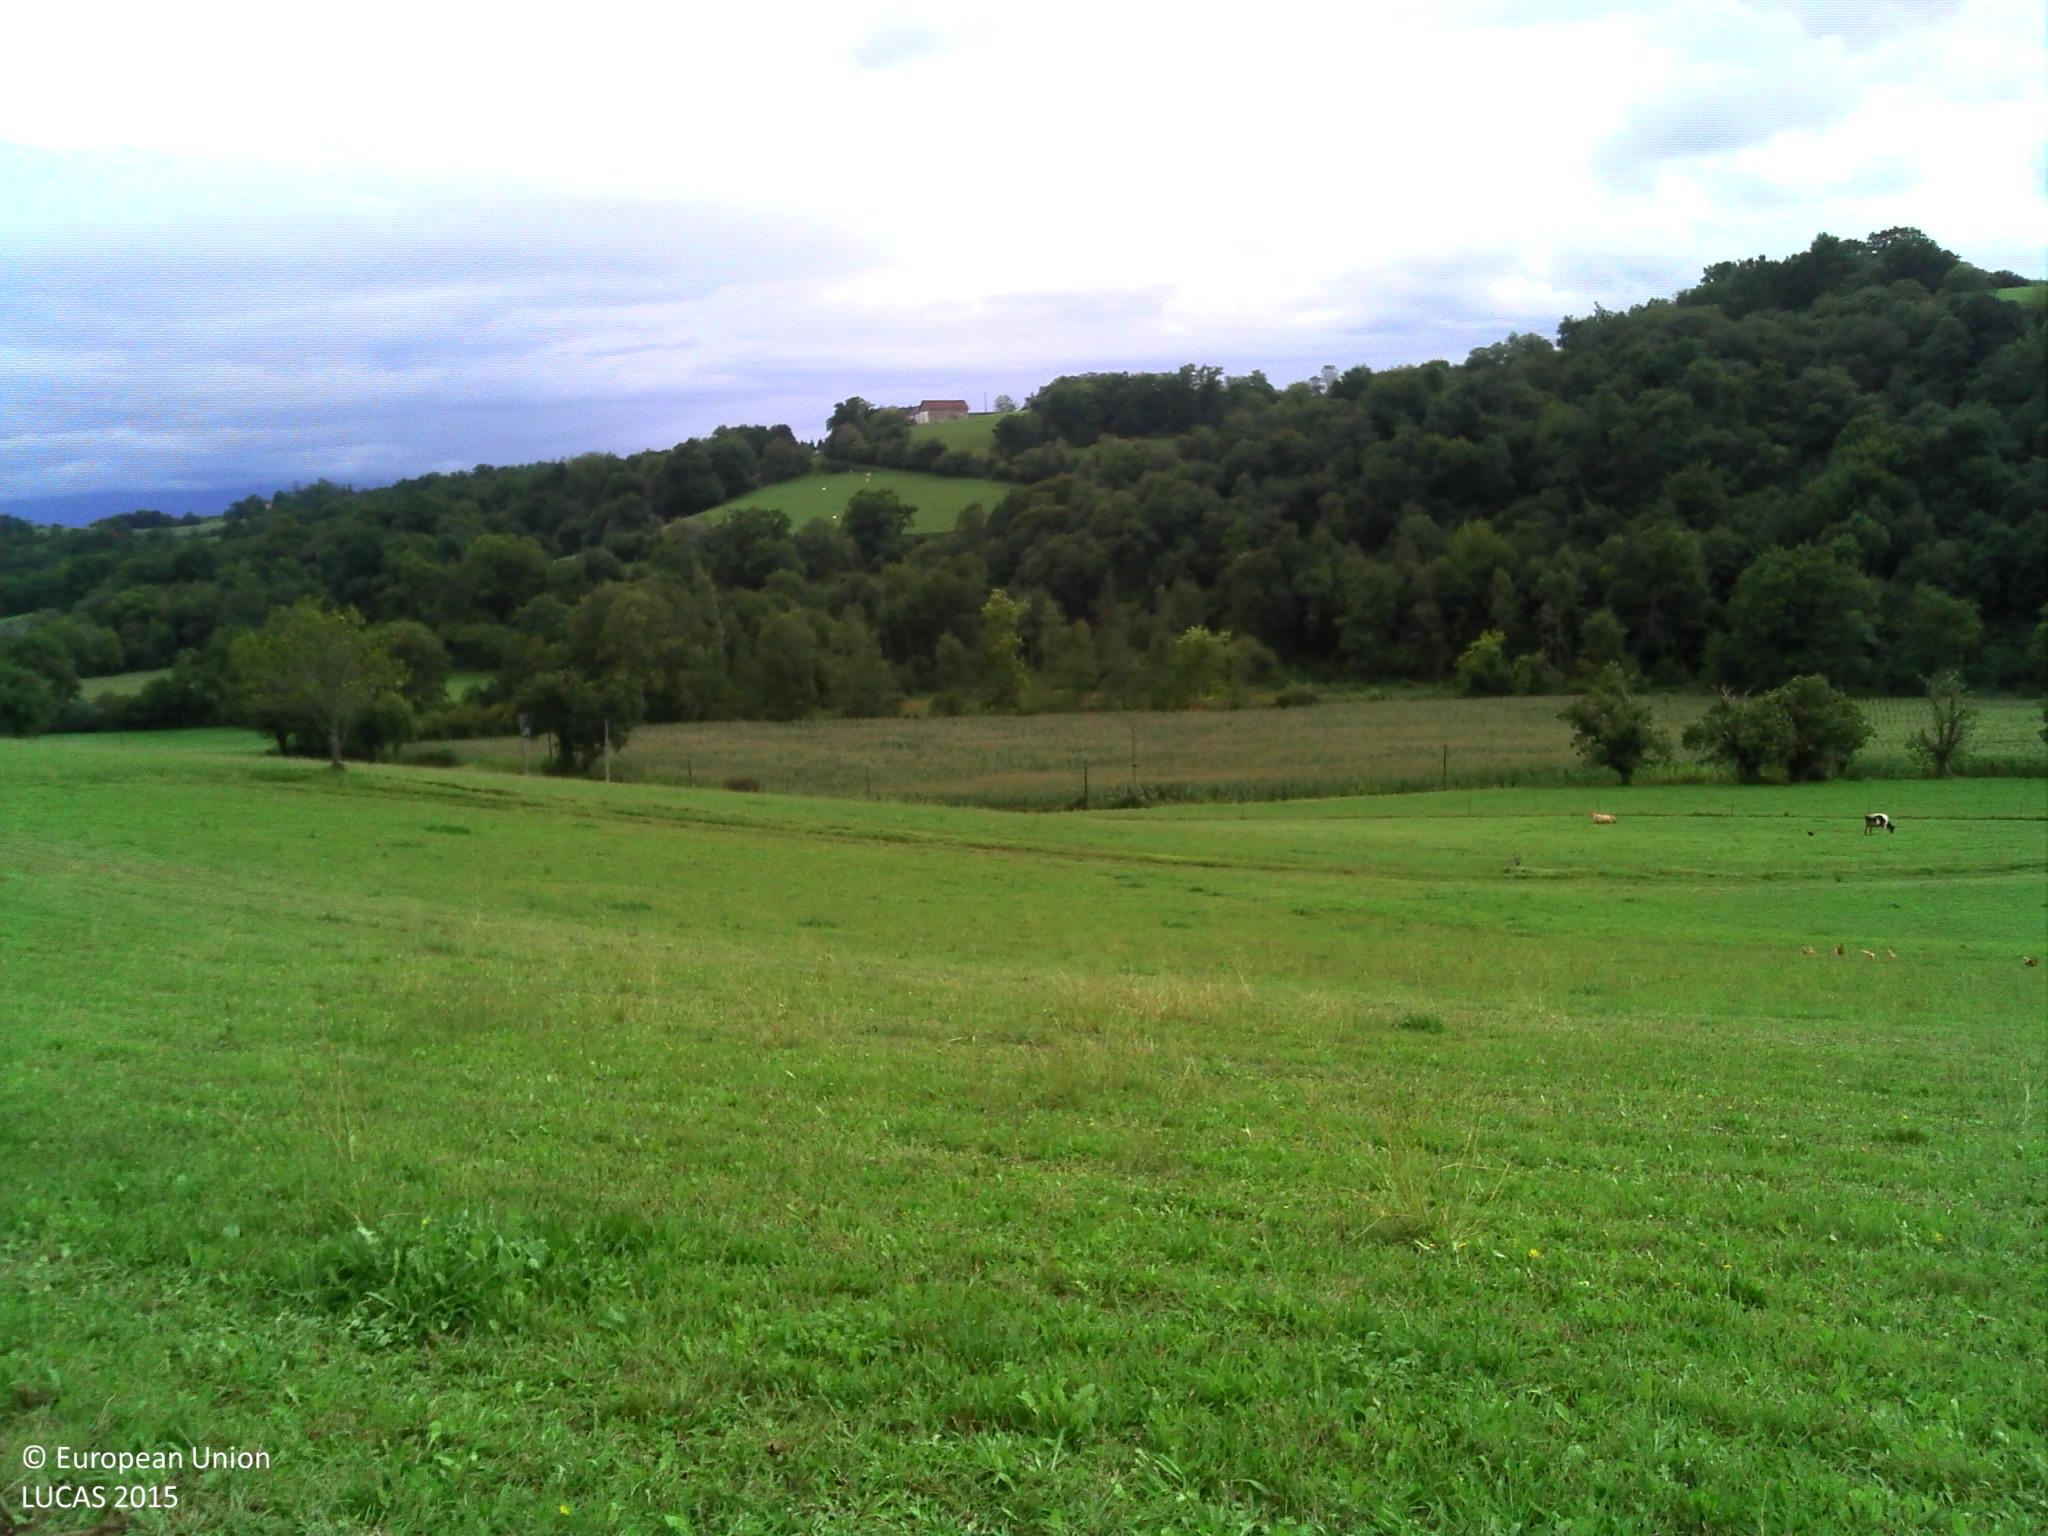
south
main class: Grassland
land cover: Grassland without tree/shrub cover
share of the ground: > 75 %
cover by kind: herbaceous plants 90 %, unconsolidated bare surface 10 %
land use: Agriculture (excluding fallow land and kitchen gardens)
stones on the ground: < 10 %
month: September
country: FR
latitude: 43.2922
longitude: -0.6457
